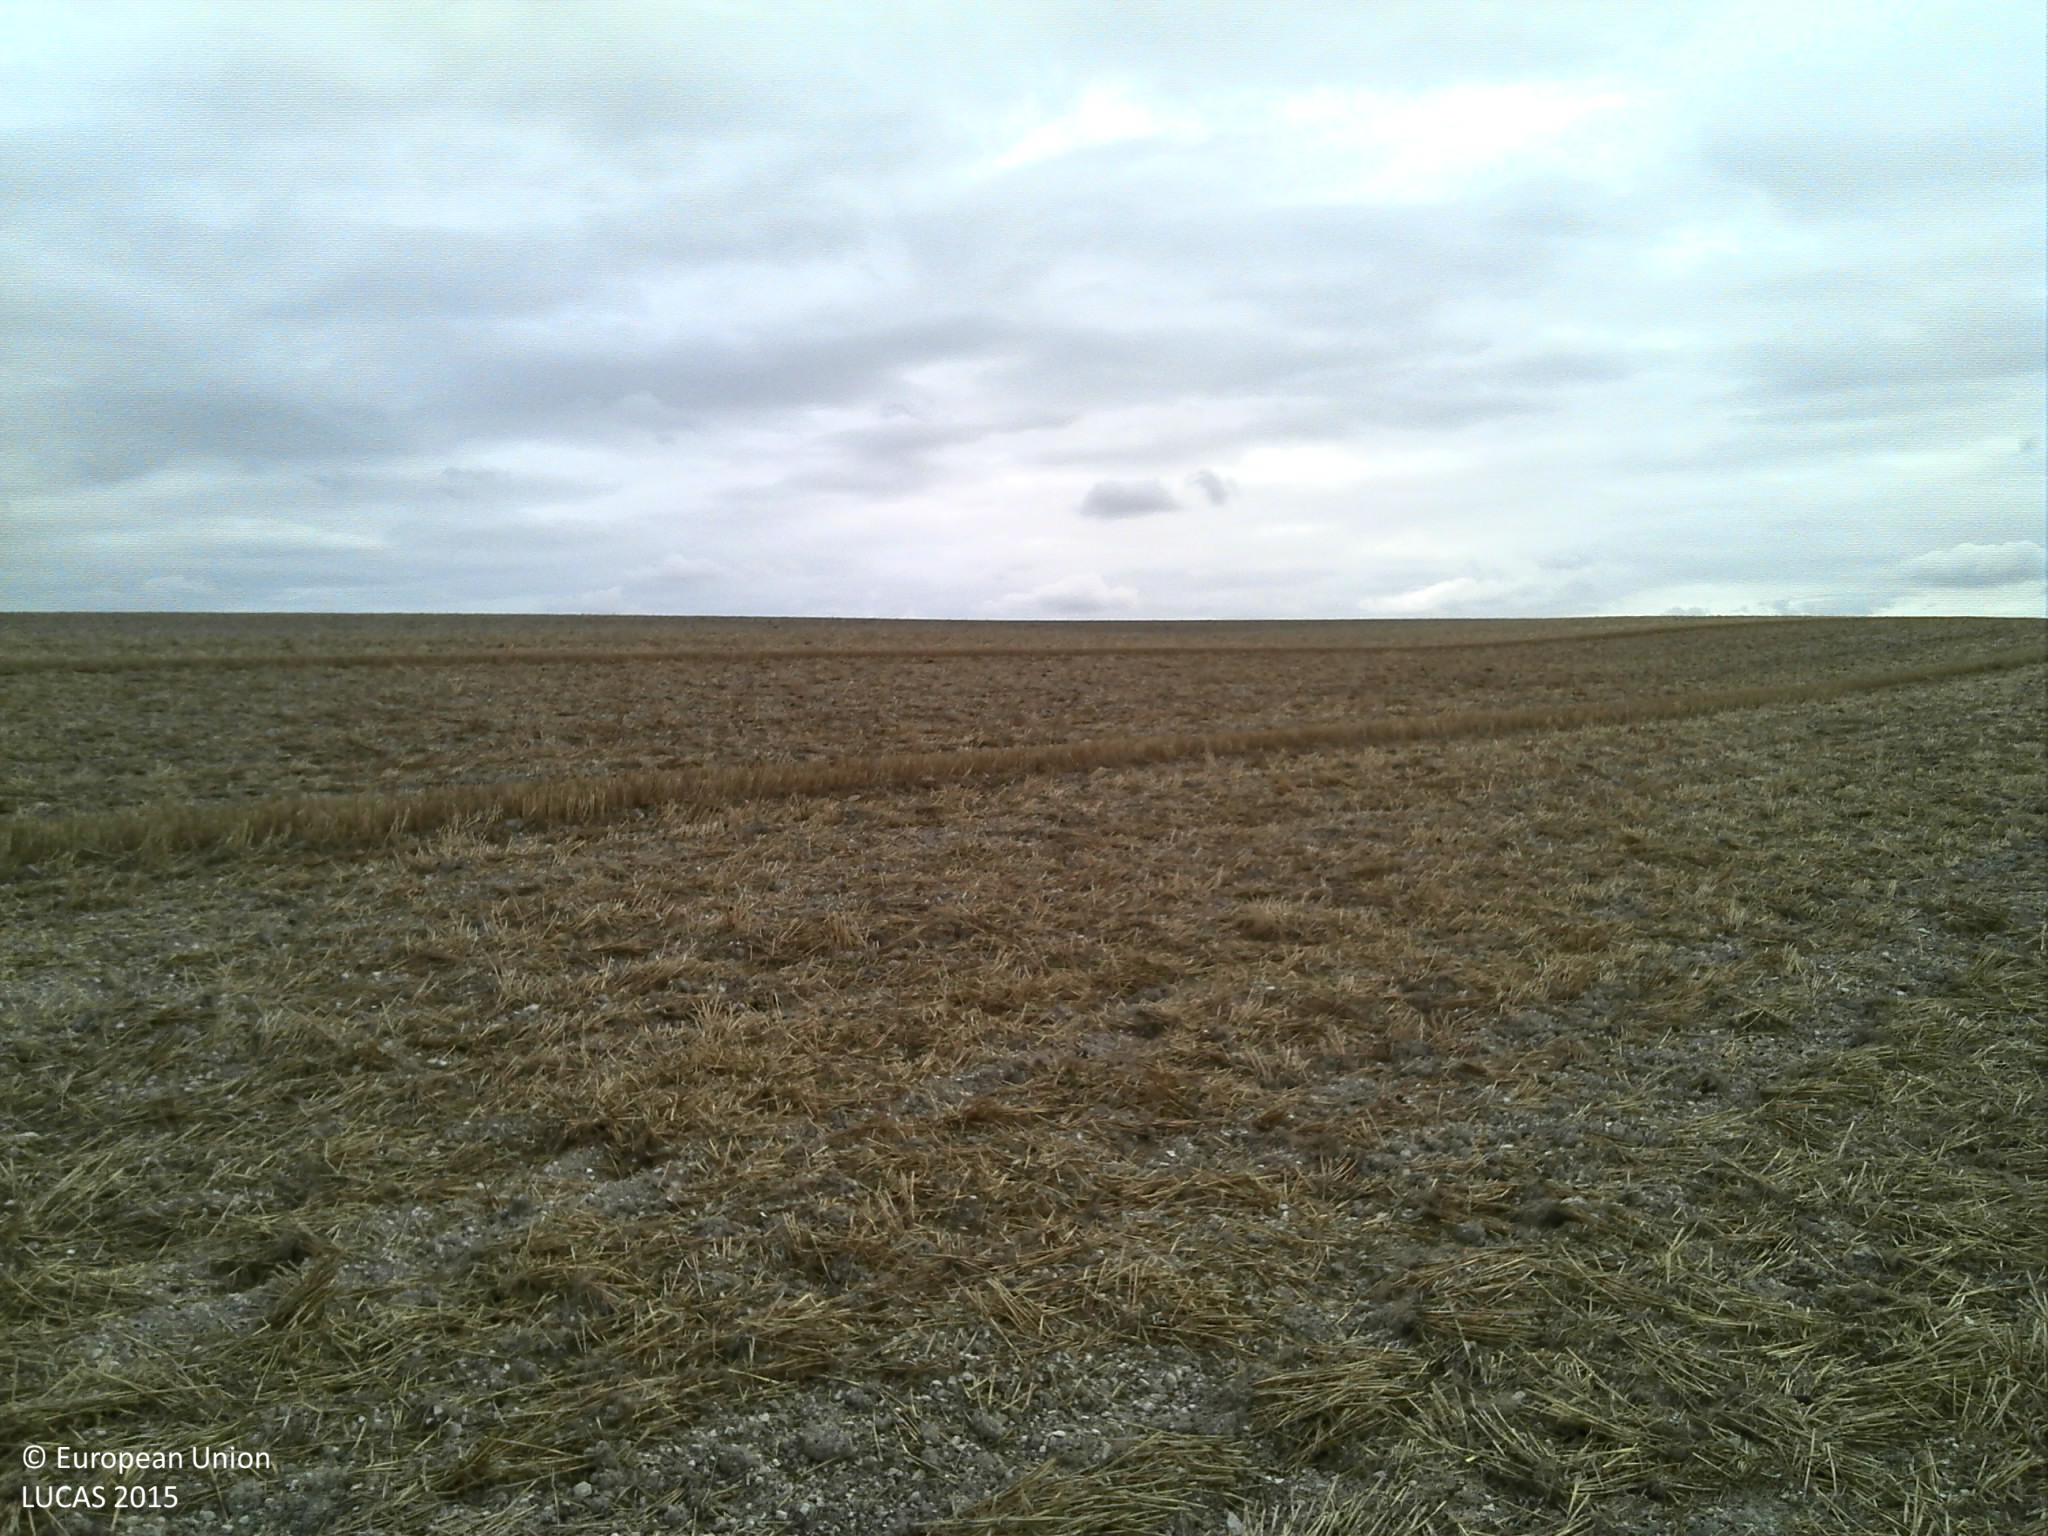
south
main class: Cropland
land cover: Common wheat
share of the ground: 25 - 50 %
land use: Agriculture (excluding fallow land and kitchen gardens)
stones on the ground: 10 - 25 %
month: August
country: FR
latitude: 48.4882
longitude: 4.2461
